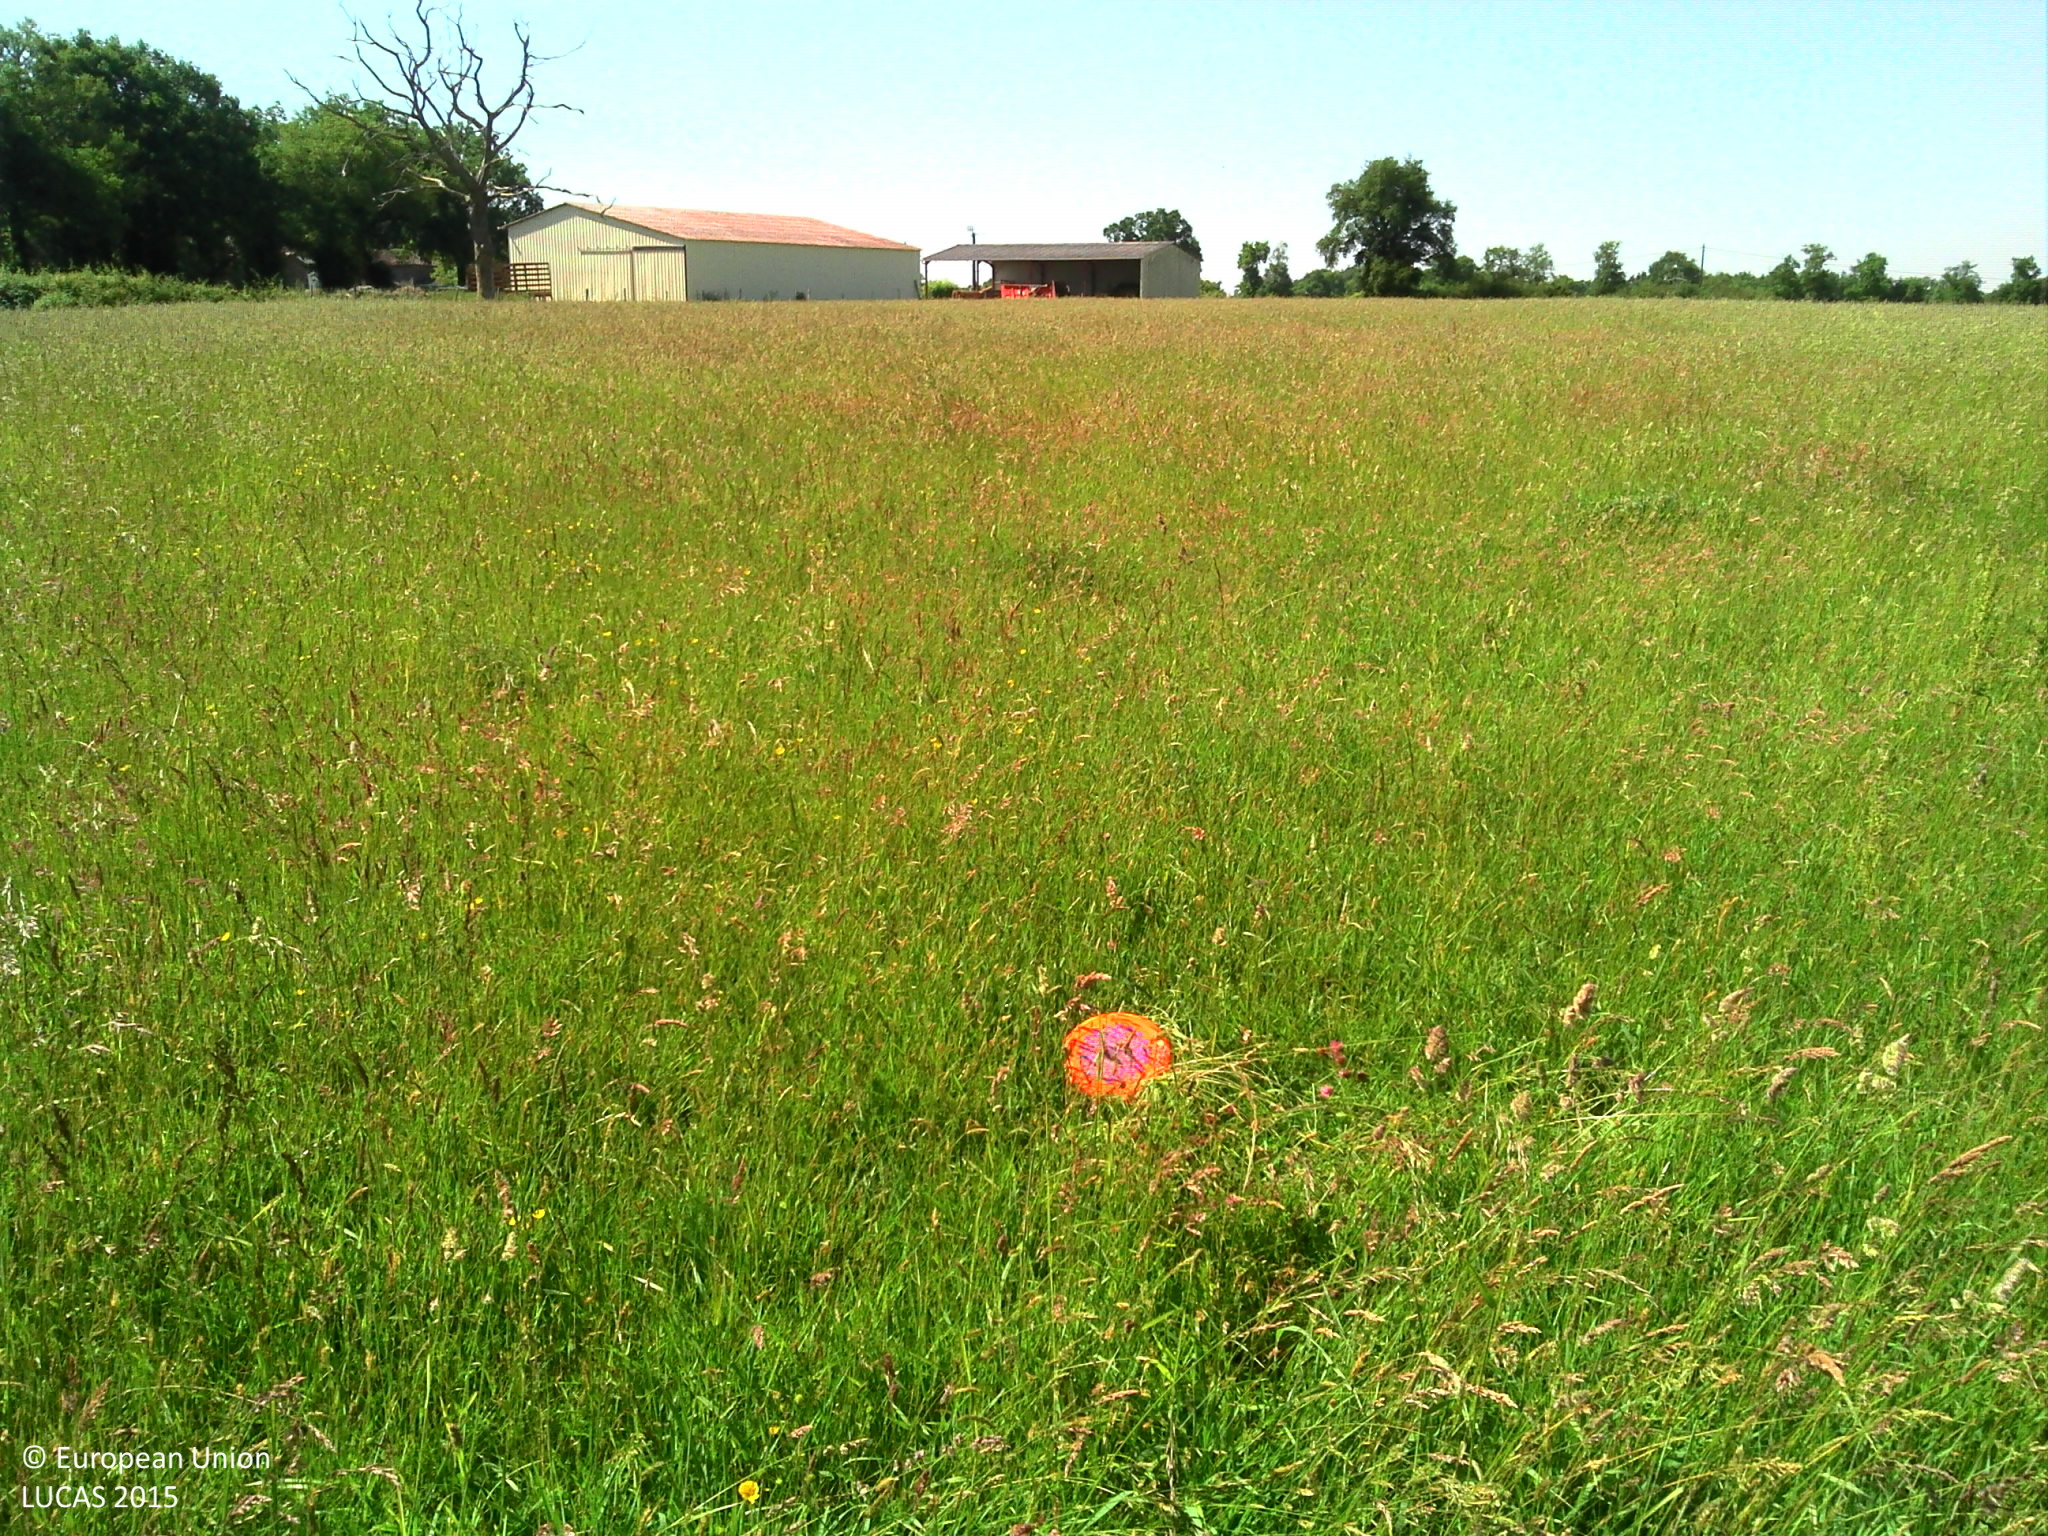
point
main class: Grassland
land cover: Grassland without tree/shrub cover
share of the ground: > 75 %
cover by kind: herbaceous plants 100 %
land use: Agriculture (excluding fallow land and kitchen gardens)
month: June
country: FR
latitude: 46.0466
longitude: 0.6160
